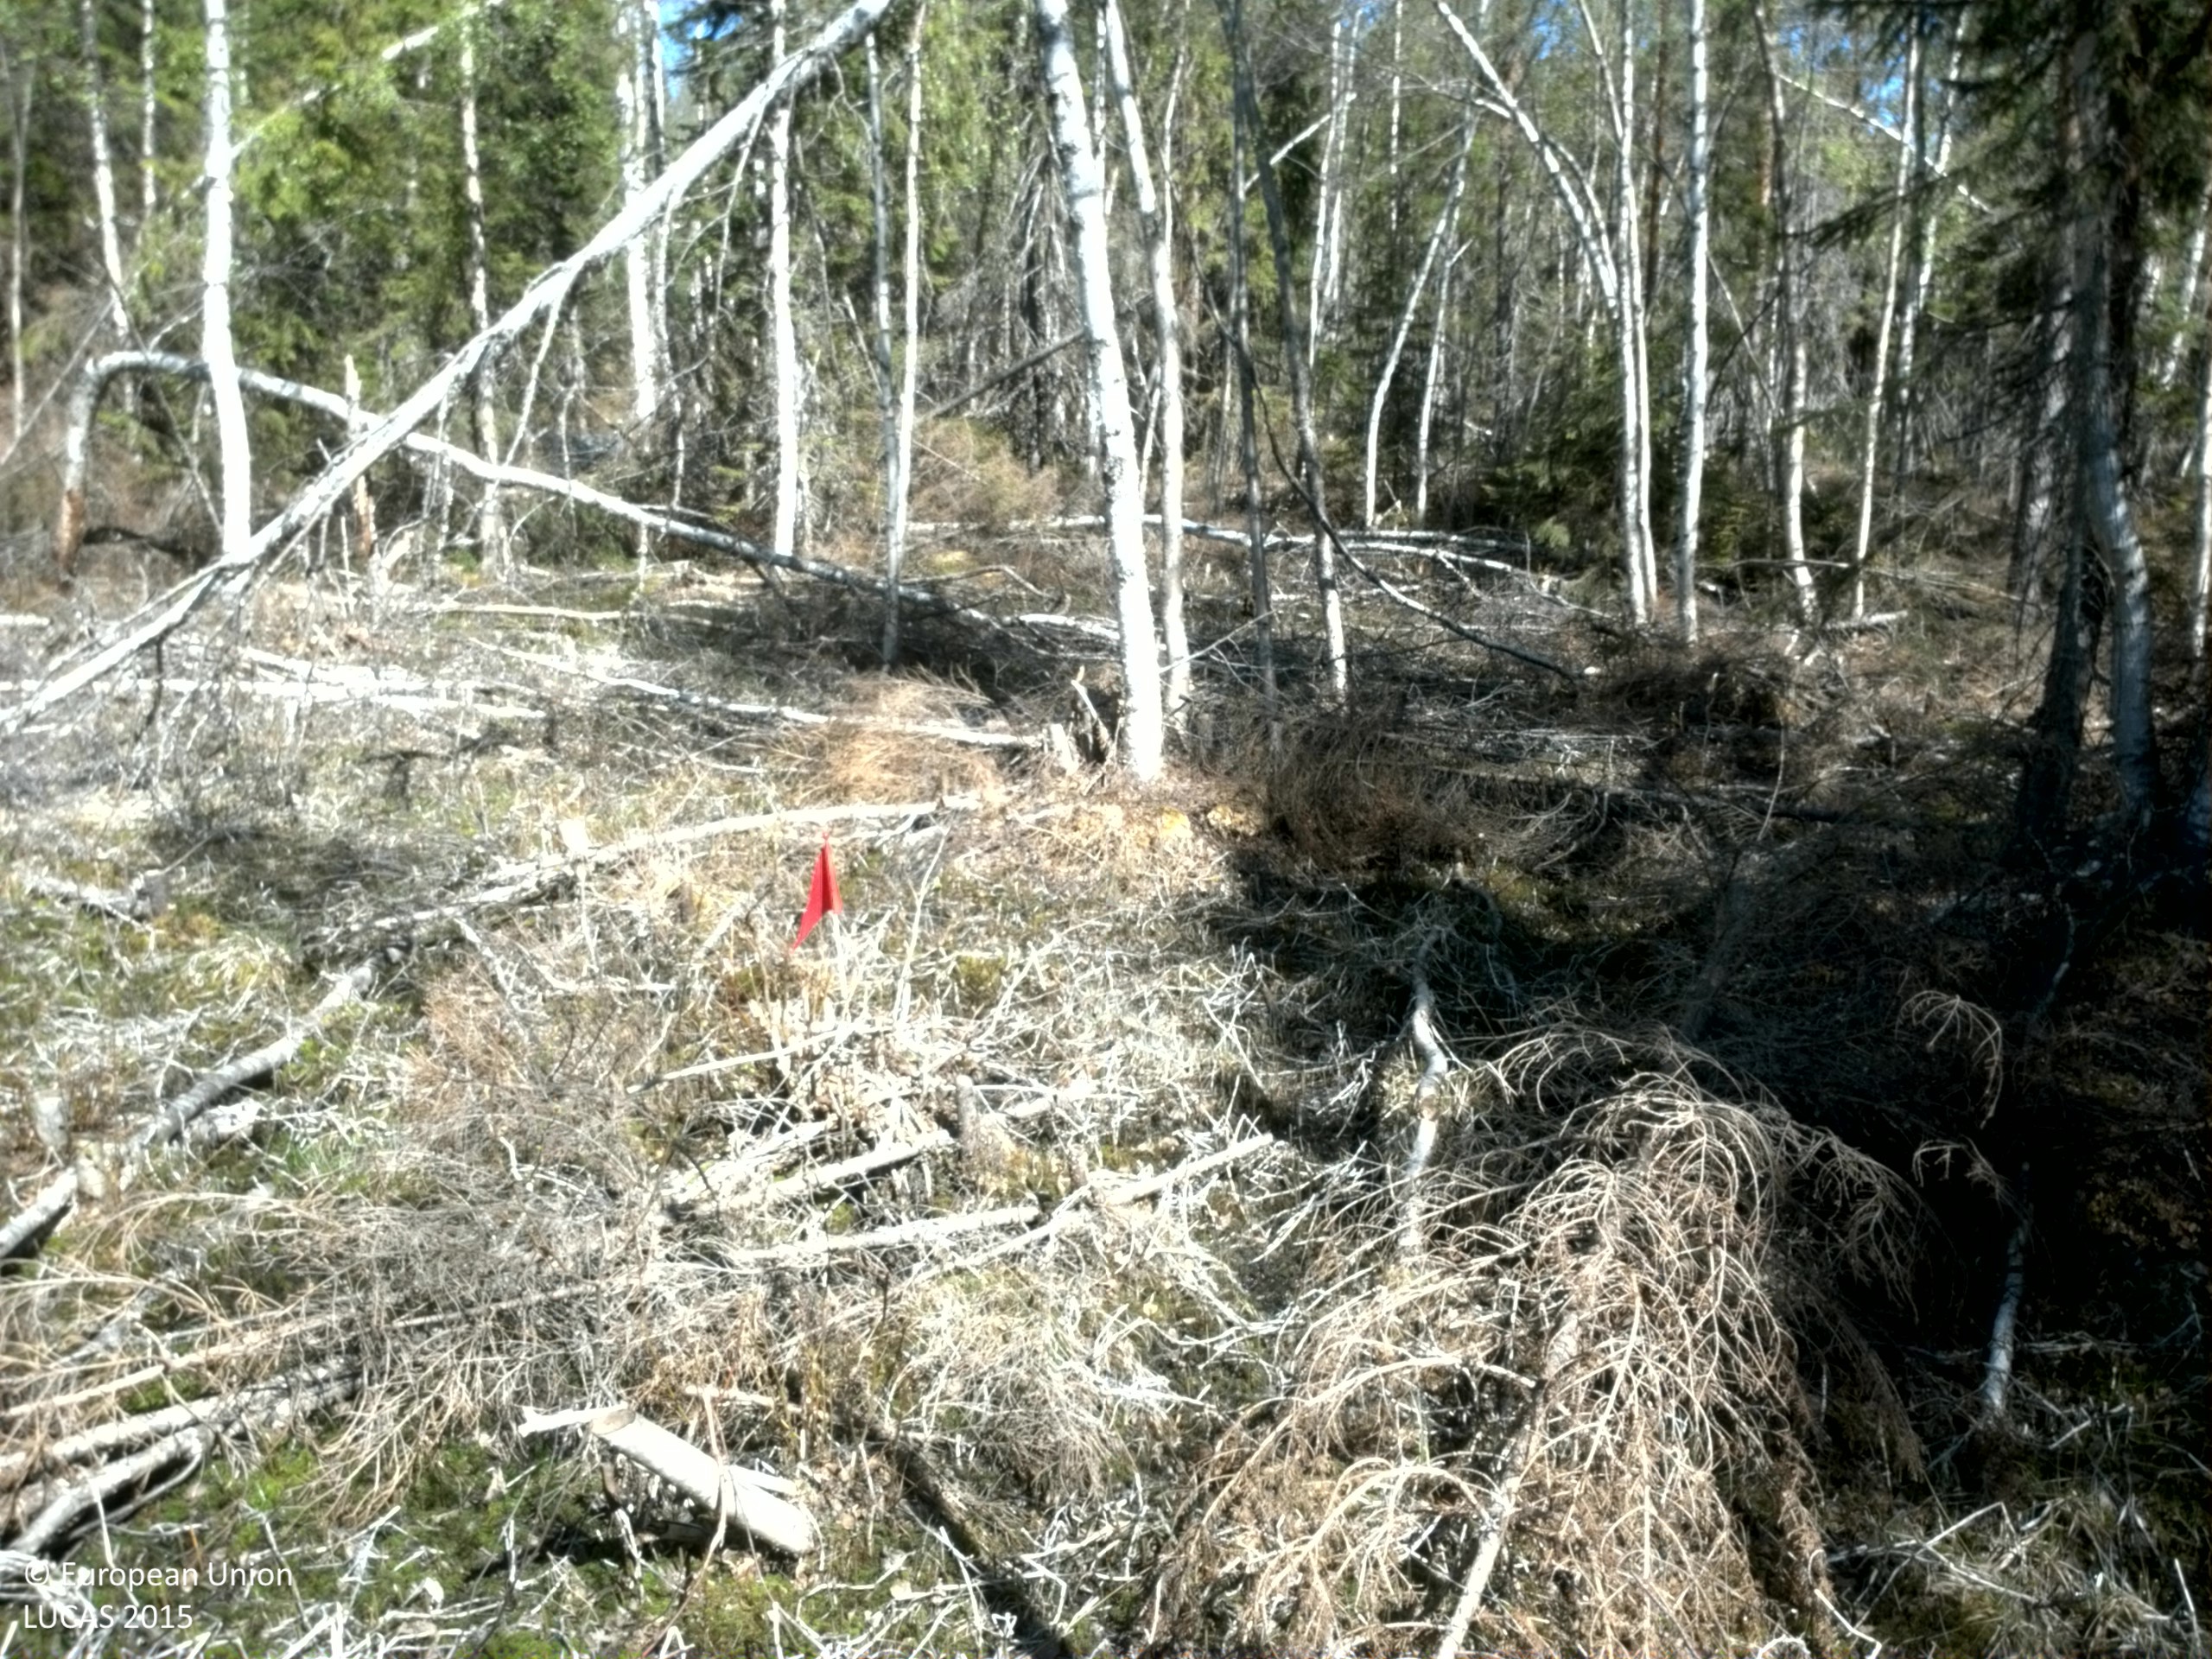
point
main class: Woodland
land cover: Spruce dominated mixed woodland
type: boreal forest
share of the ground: 10 - 25 %
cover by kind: shrubs 20 %, unconsolidated bare surface 20 %, lichens and mosses 15 %, broadleaved forest trees 10 %, coniferous forest trees 5 %
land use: Forestry
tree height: > 5 m
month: May
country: SE
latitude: 63.0690
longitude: 18.0324
